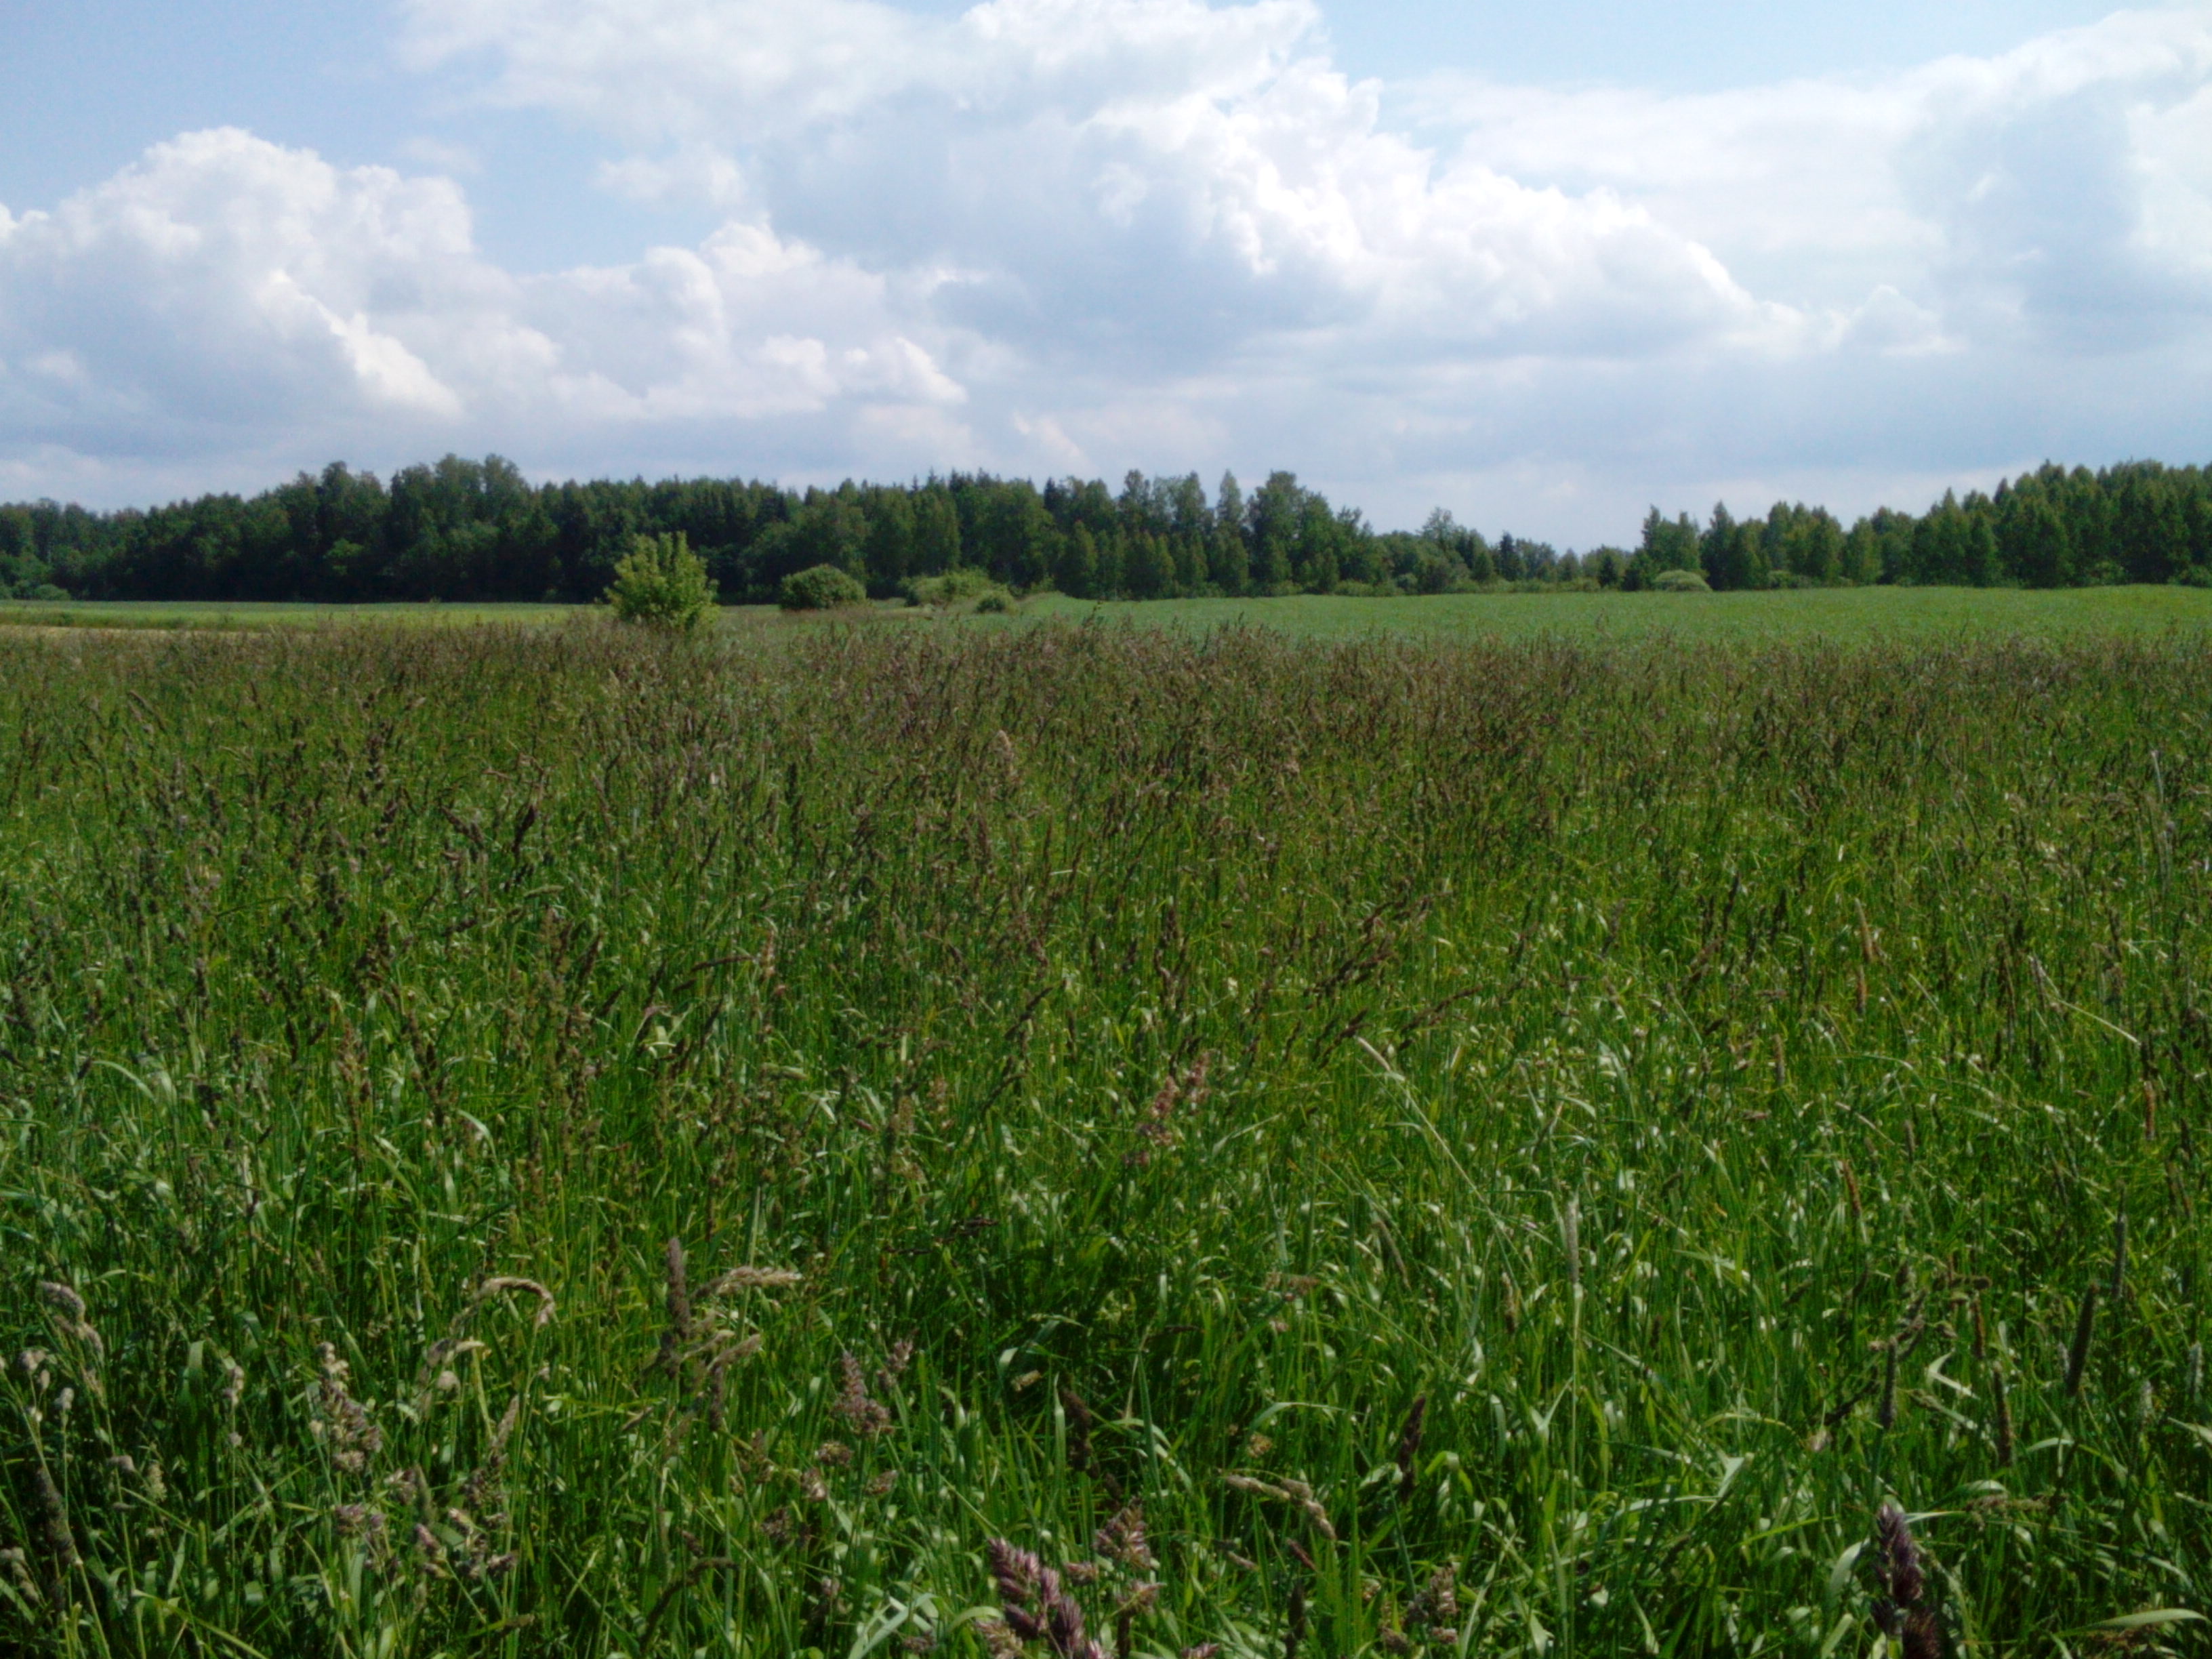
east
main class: Grassland
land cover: Grassland without tree/shrub cover
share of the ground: > 75 %
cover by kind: herbaceous plants 100 %
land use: Agriculture (excluding fallow land and kitchen gardens)
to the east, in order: Grassland without tree/shrub cover; Common wheat; Grass margins; Tracks; Grass margins; Grassland without tree/shrub cover; Common wheat
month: June
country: LV
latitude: 56.7970
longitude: 22.2836
